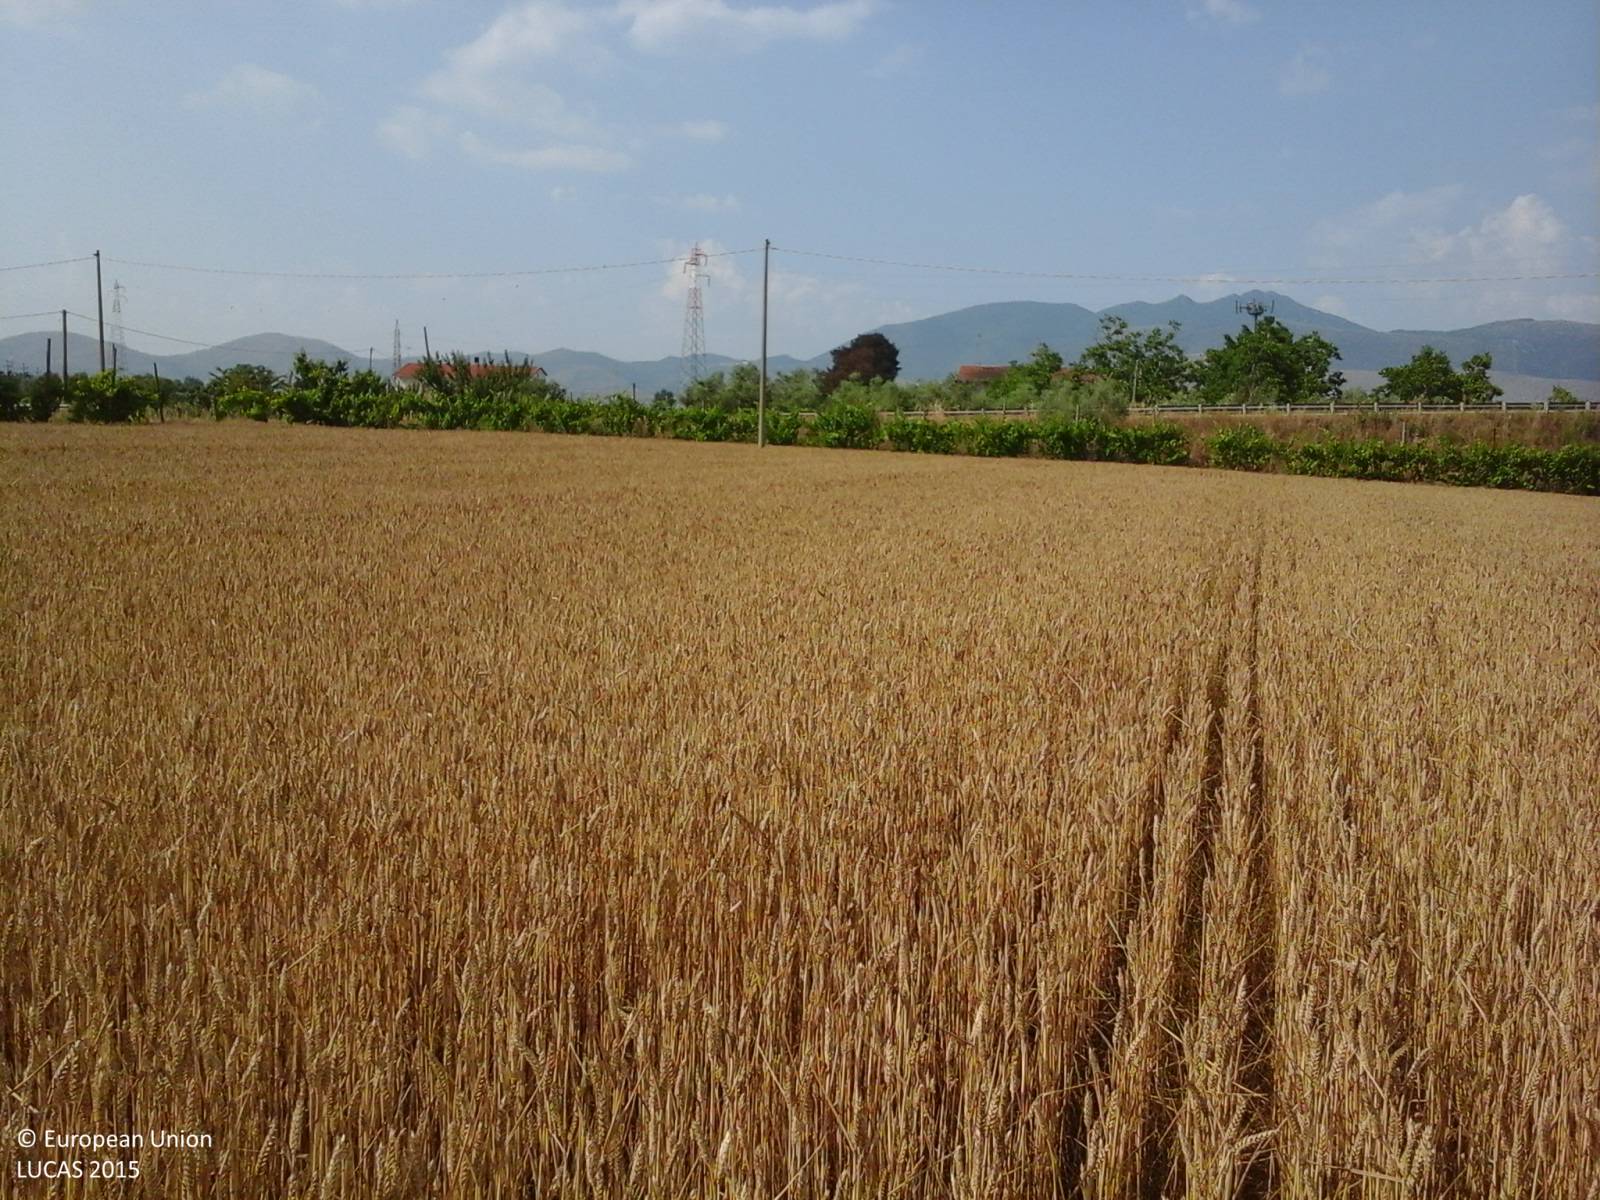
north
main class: Cropland
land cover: Common wheat
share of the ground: > 75 %
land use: Agriculture (excluding fallow land and kitchen gardens)
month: June
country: IT
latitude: 41.1580
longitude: 14.1426
